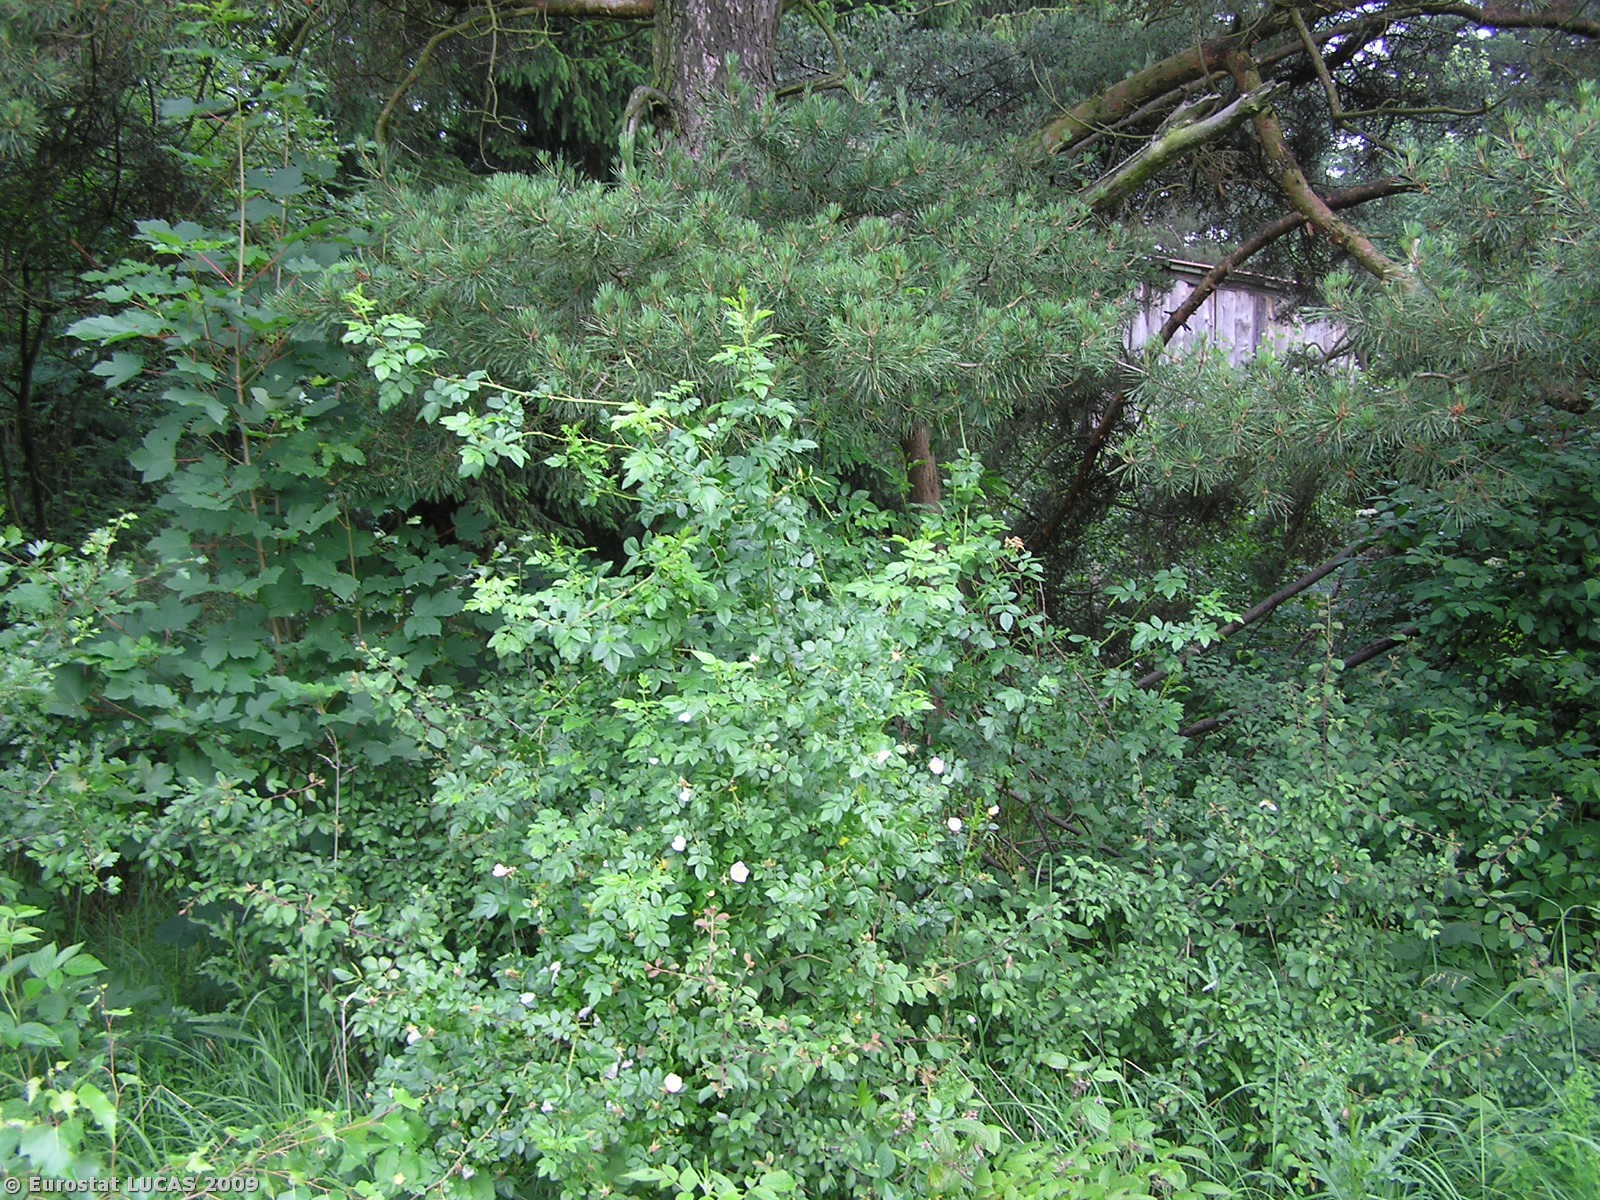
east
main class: Grassland
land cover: Grassland without tree/shrub cover
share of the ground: > 75 %
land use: Unused
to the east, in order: Grassland without tree/shrub cover; Mixed woodland; Electric lines; Mixed woodland; Artificial constructions in urban areas; Mixed woodland
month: June
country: CZ
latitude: 49.6445
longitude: 14.9465
